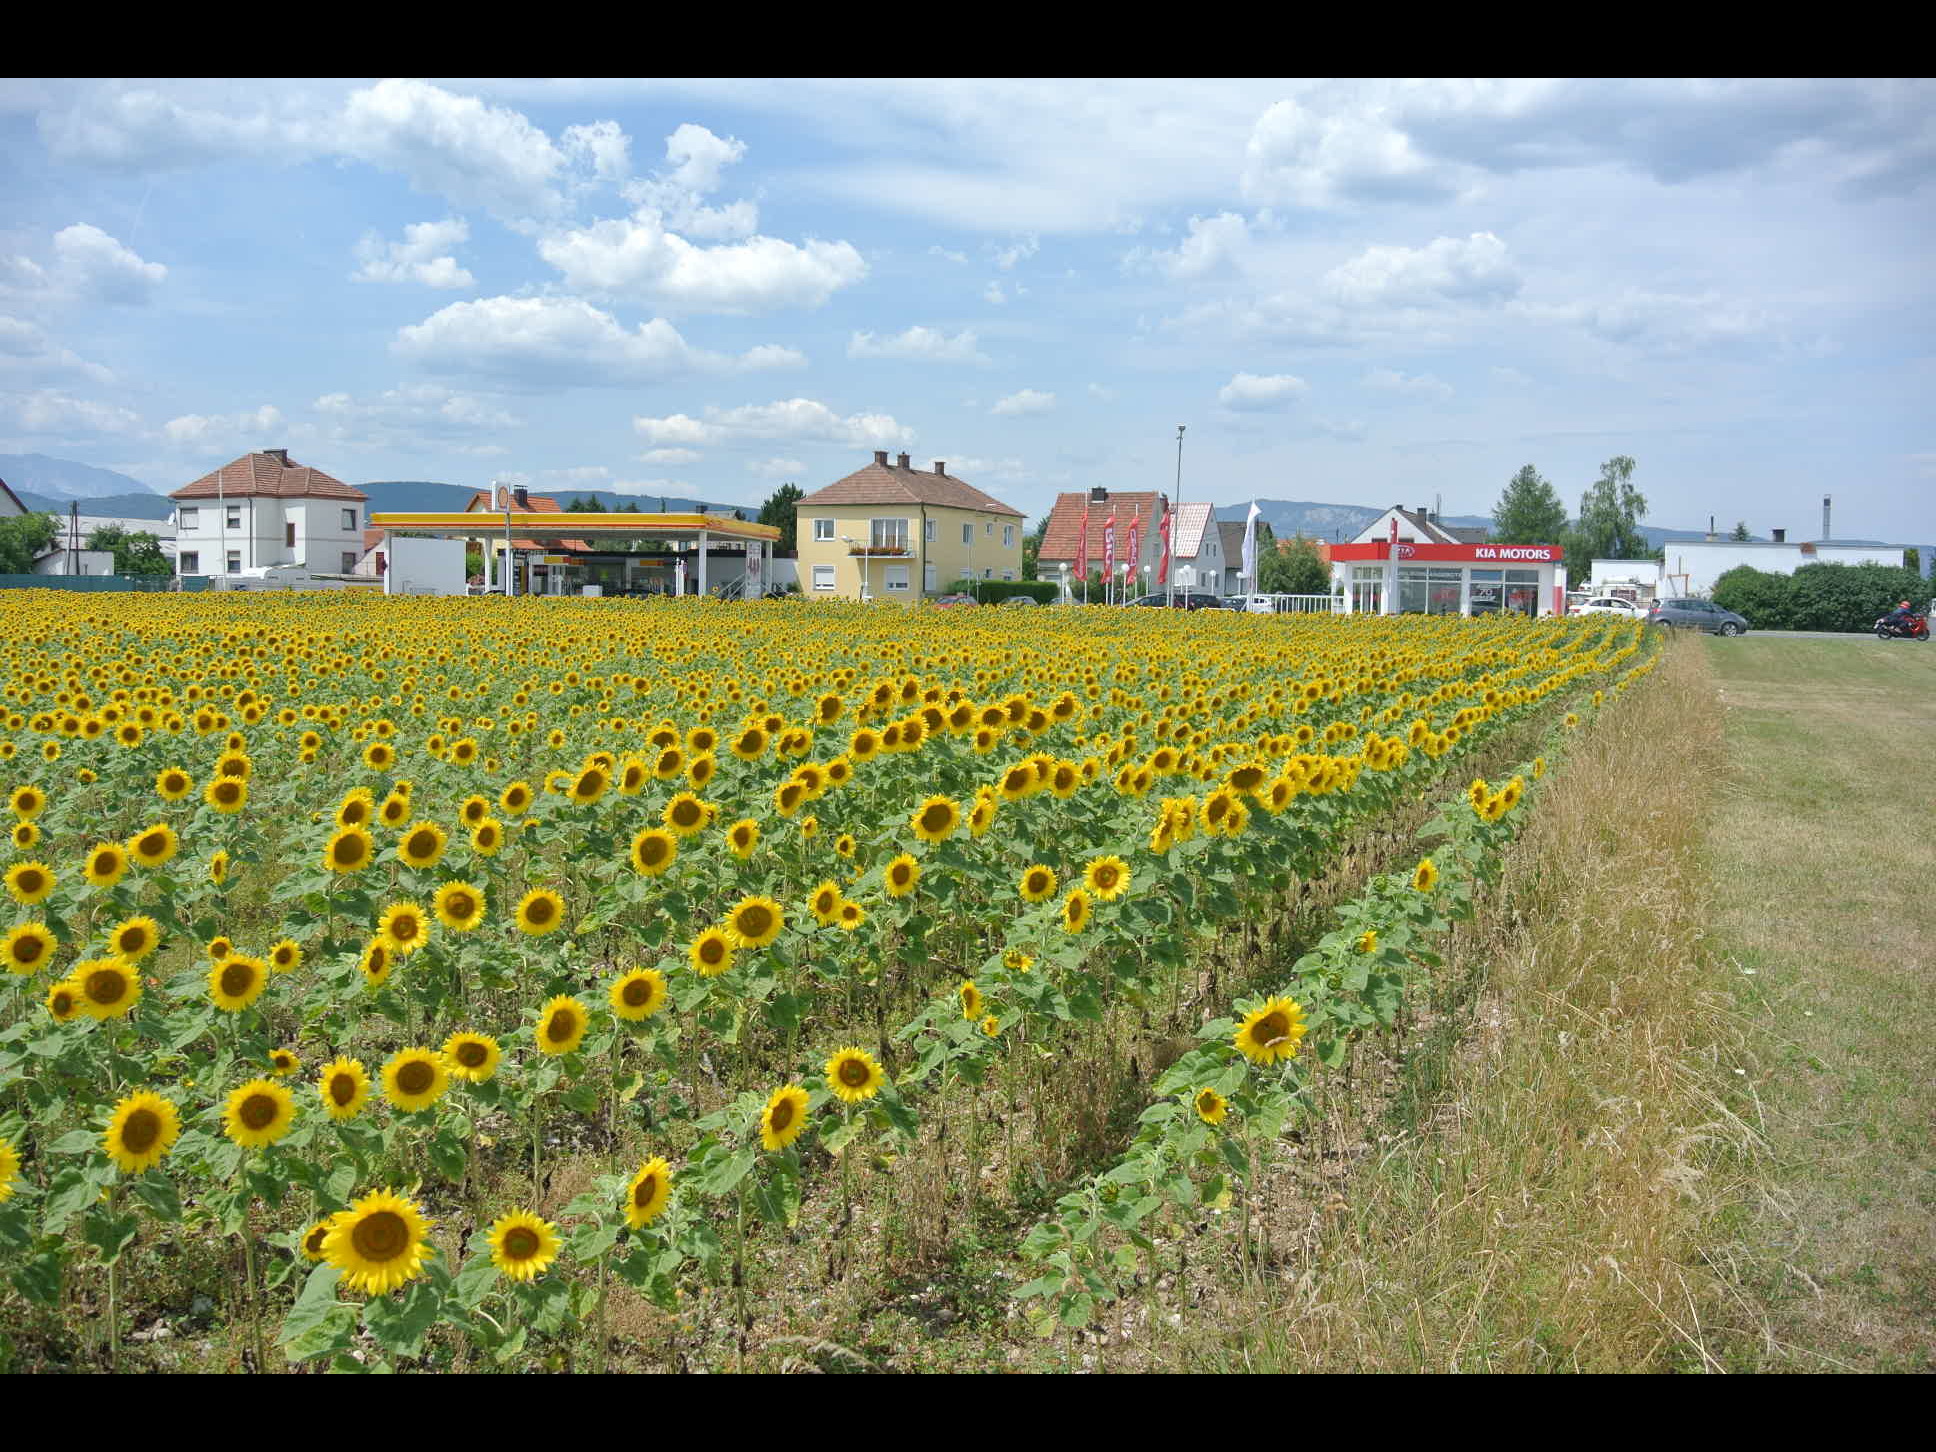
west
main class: Cropland
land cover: Sunflower
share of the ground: > 75 %
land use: Agriculture (excluding fallow land and kitchen gardens)
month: July
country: AT
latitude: 47.7300
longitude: 16.0964
